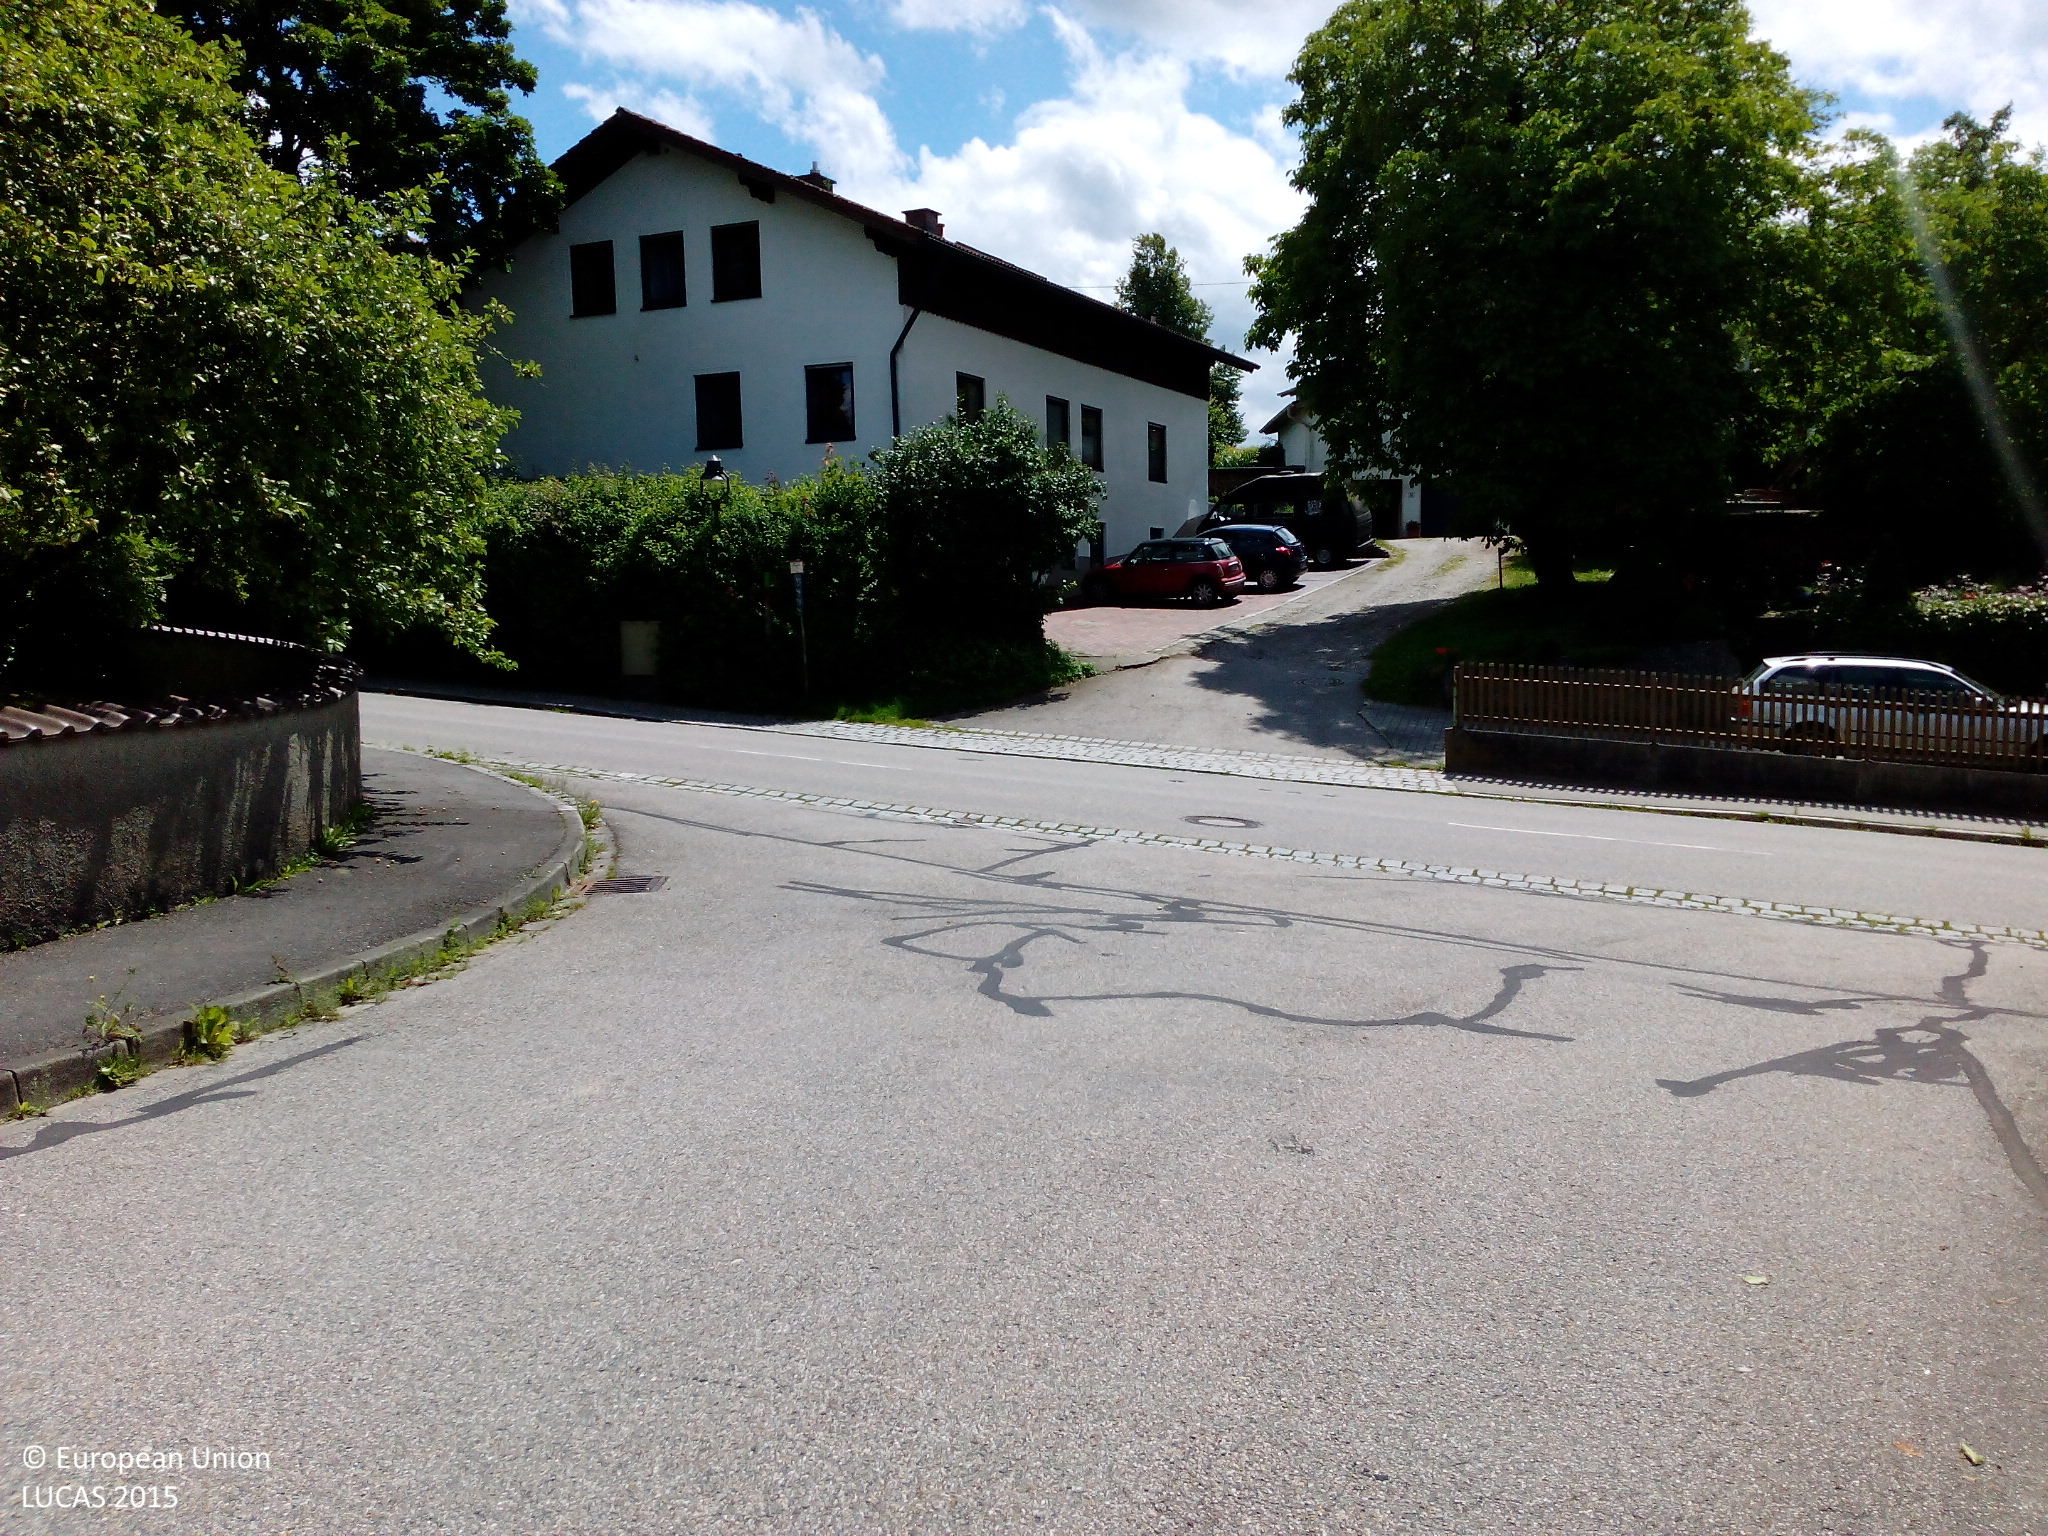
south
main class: Grassland
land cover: Grassland without tree/shrub cover
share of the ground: > 75 %
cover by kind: herbaceous plants 100 %
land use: Residential
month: June
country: DE
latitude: 48.3058
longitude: 12.3854
